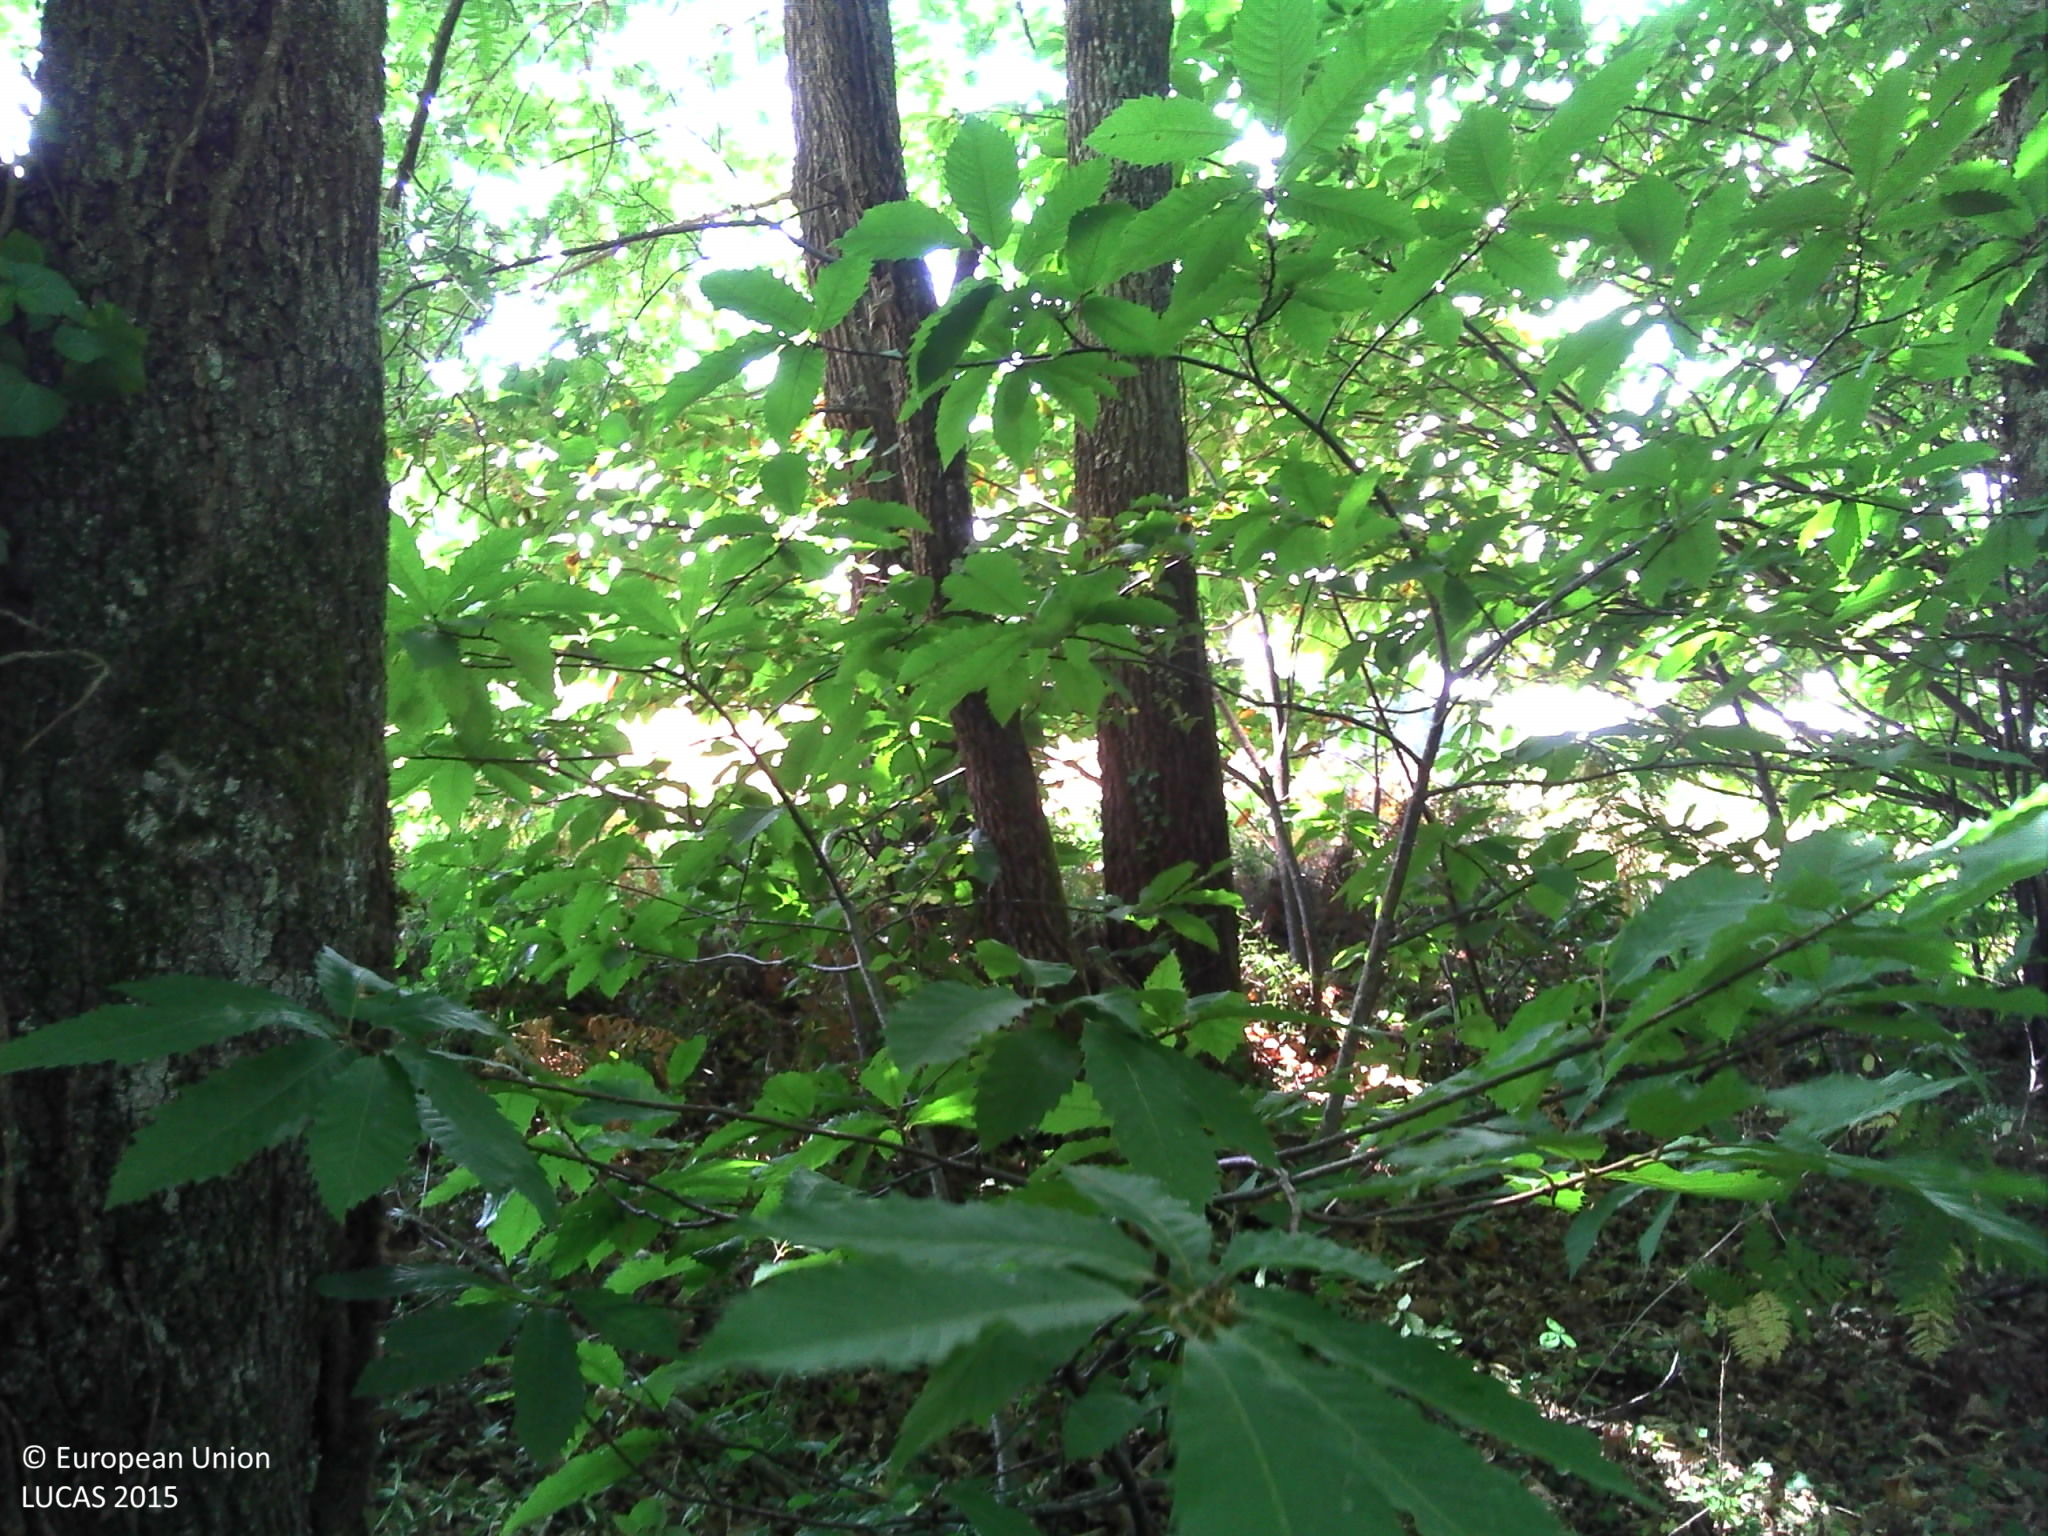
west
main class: Woodland
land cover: Broadleaved woodland
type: thermophilous deciduous forest
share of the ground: > 75 %
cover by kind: broadleaved forest trees 80 %, herbaceous plants 10 %, coniferous forest trees 5 %, shrubs 5 %
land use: Forestry
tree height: > 5 m
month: July
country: FR
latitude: 45.0775
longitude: 0.5256
